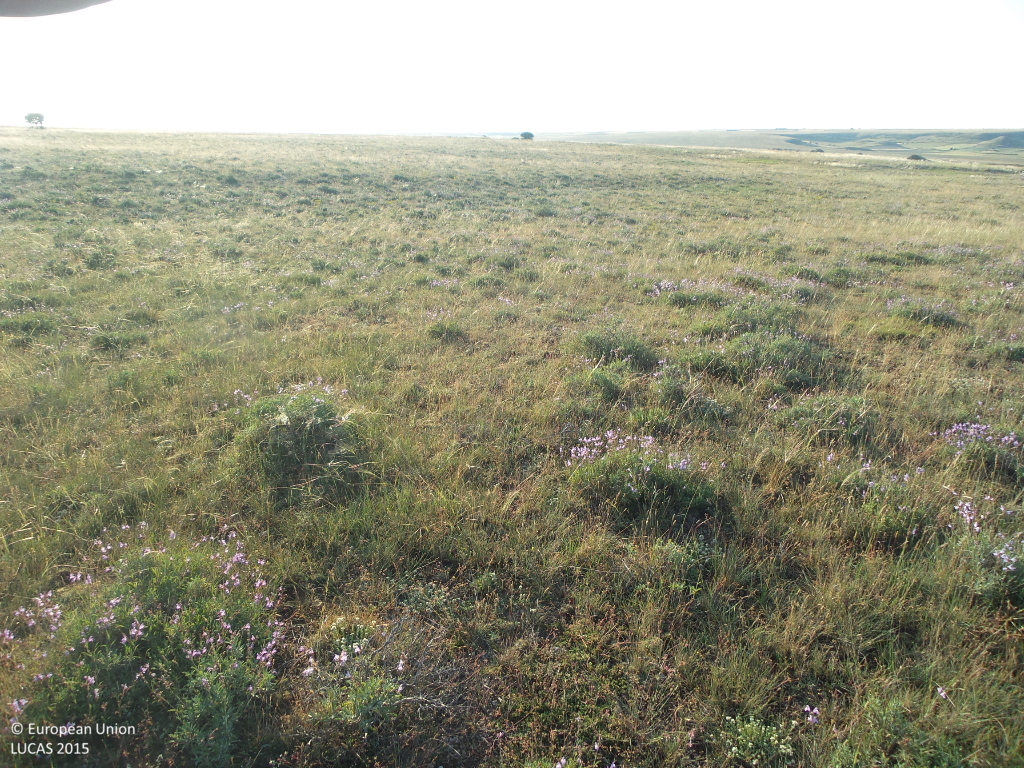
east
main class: Shrubland
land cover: Shrubland without tree cover
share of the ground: 25 - 50 %
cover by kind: shrubs 40 %, herbaceous plants 40 %, unconsolidated bare surface 20 %
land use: Semi-natural and natural areas not in use
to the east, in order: Shrubland without tree cover
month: June
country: ES
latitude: 41.3377
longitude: -2.7149
